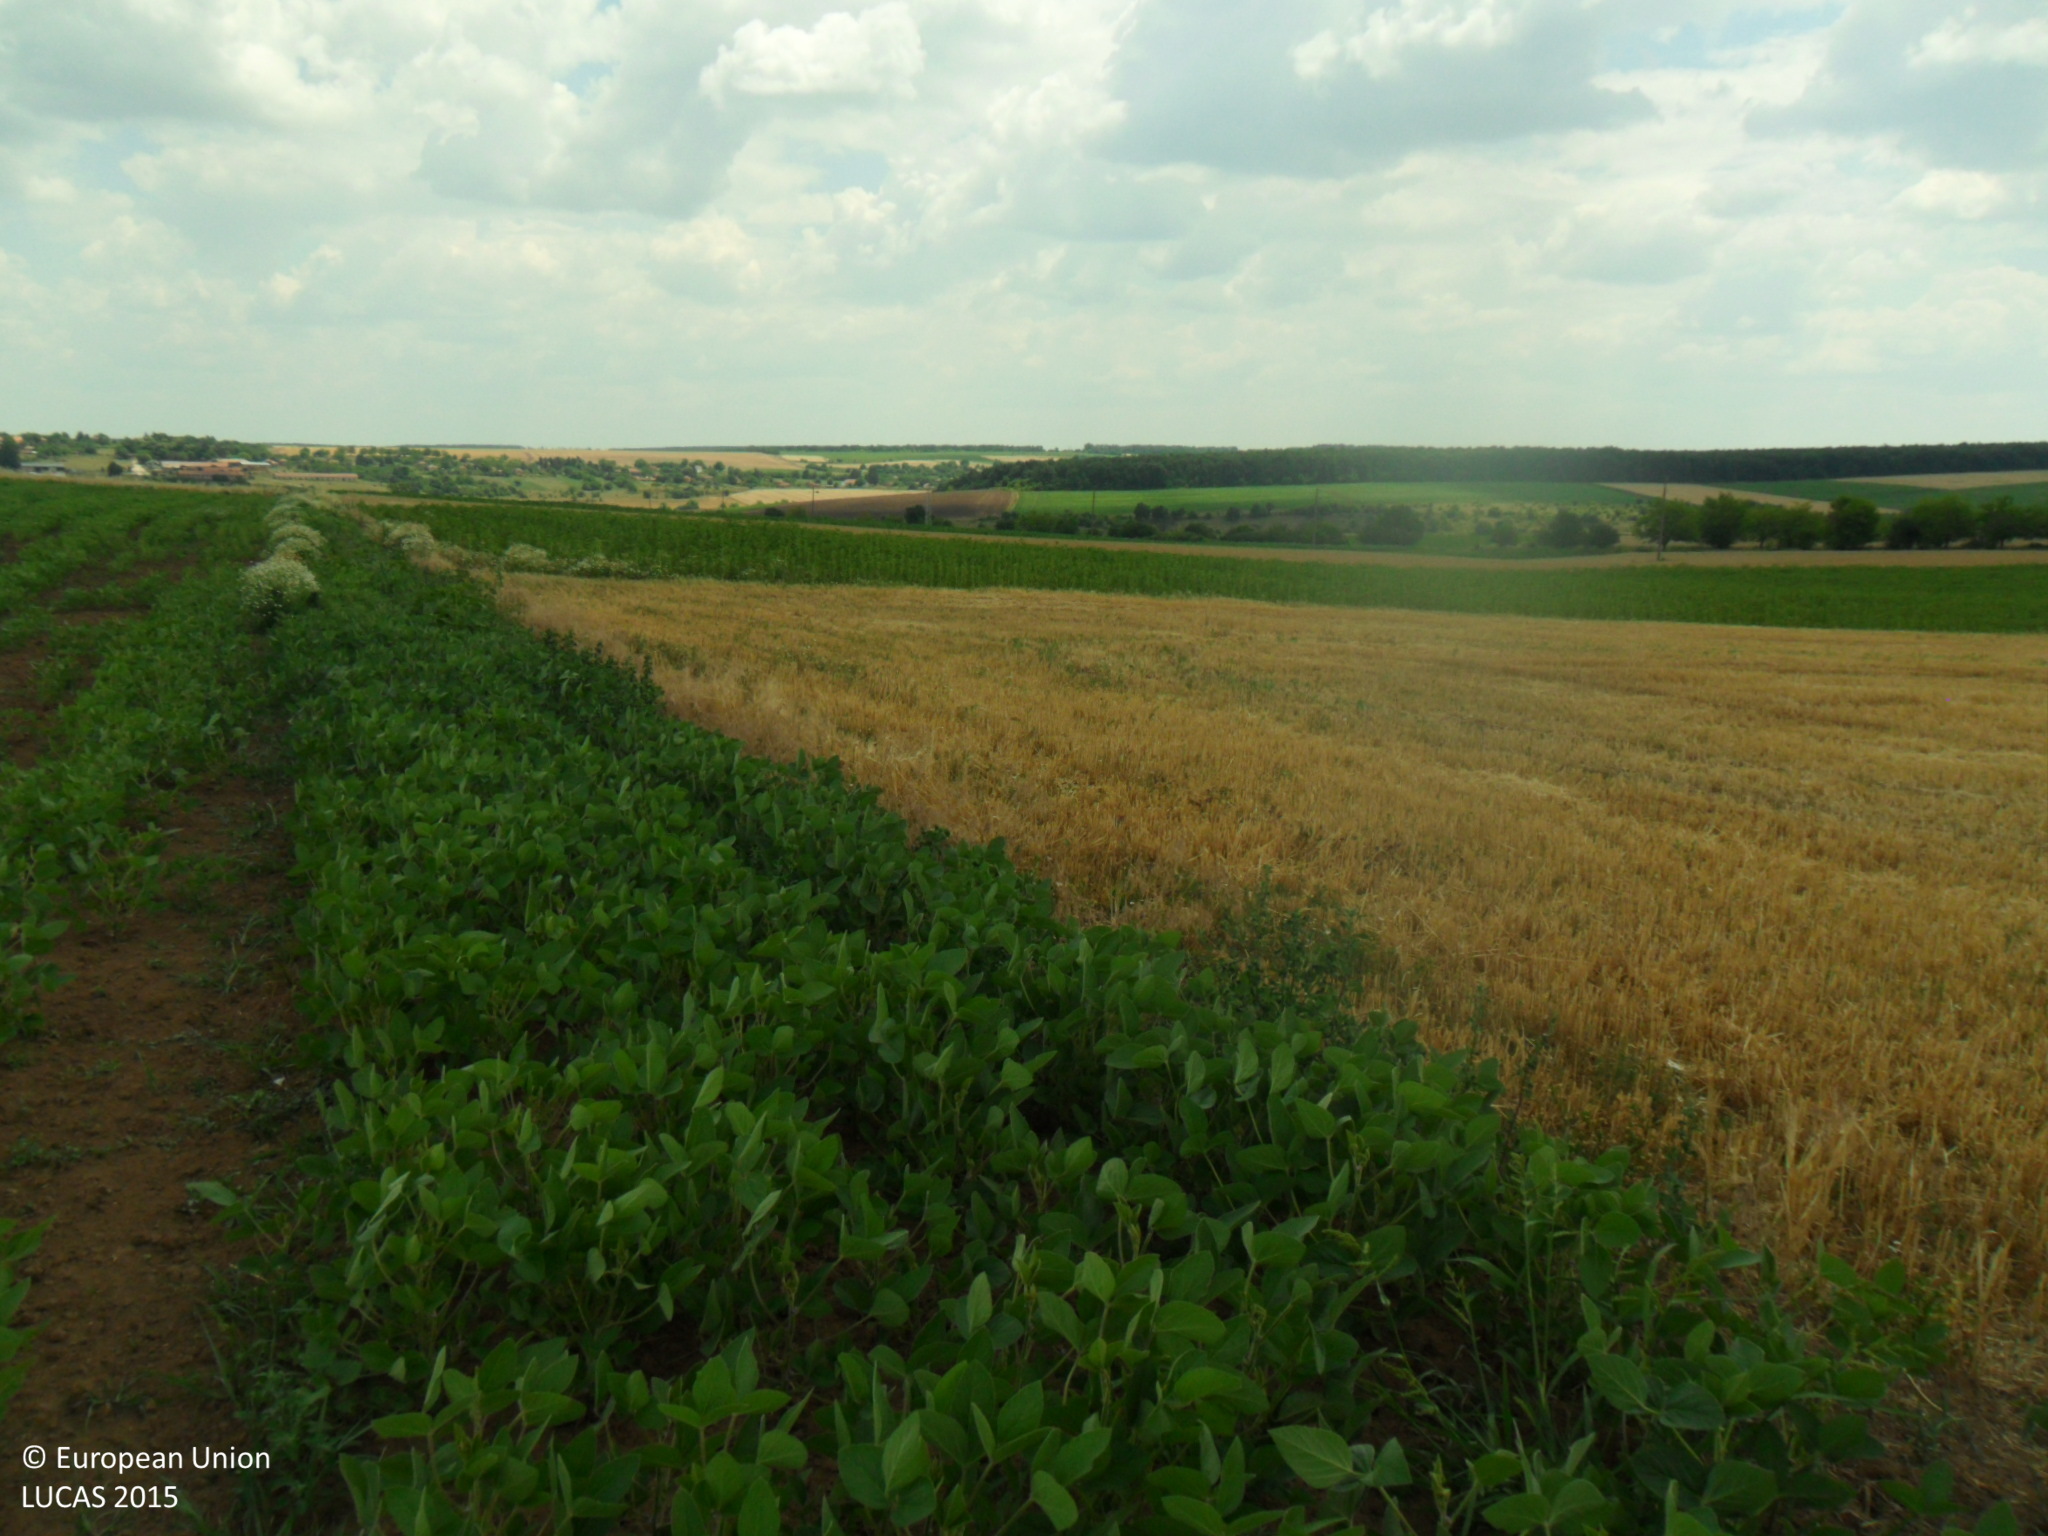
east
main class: Cropland
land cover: Soya
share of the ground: 50 - 75 %
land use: Agriculture (excluding fallow land and kitchen gardens)
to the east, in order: Soya; Barley; Grass margins; Sunflower; Common wheat; Grass margins; Spontaneously vegetated surfaces; Maize; Grass margins; Temporary grasslands
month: July
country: BG
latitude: 43.6351
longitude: 26.8867
